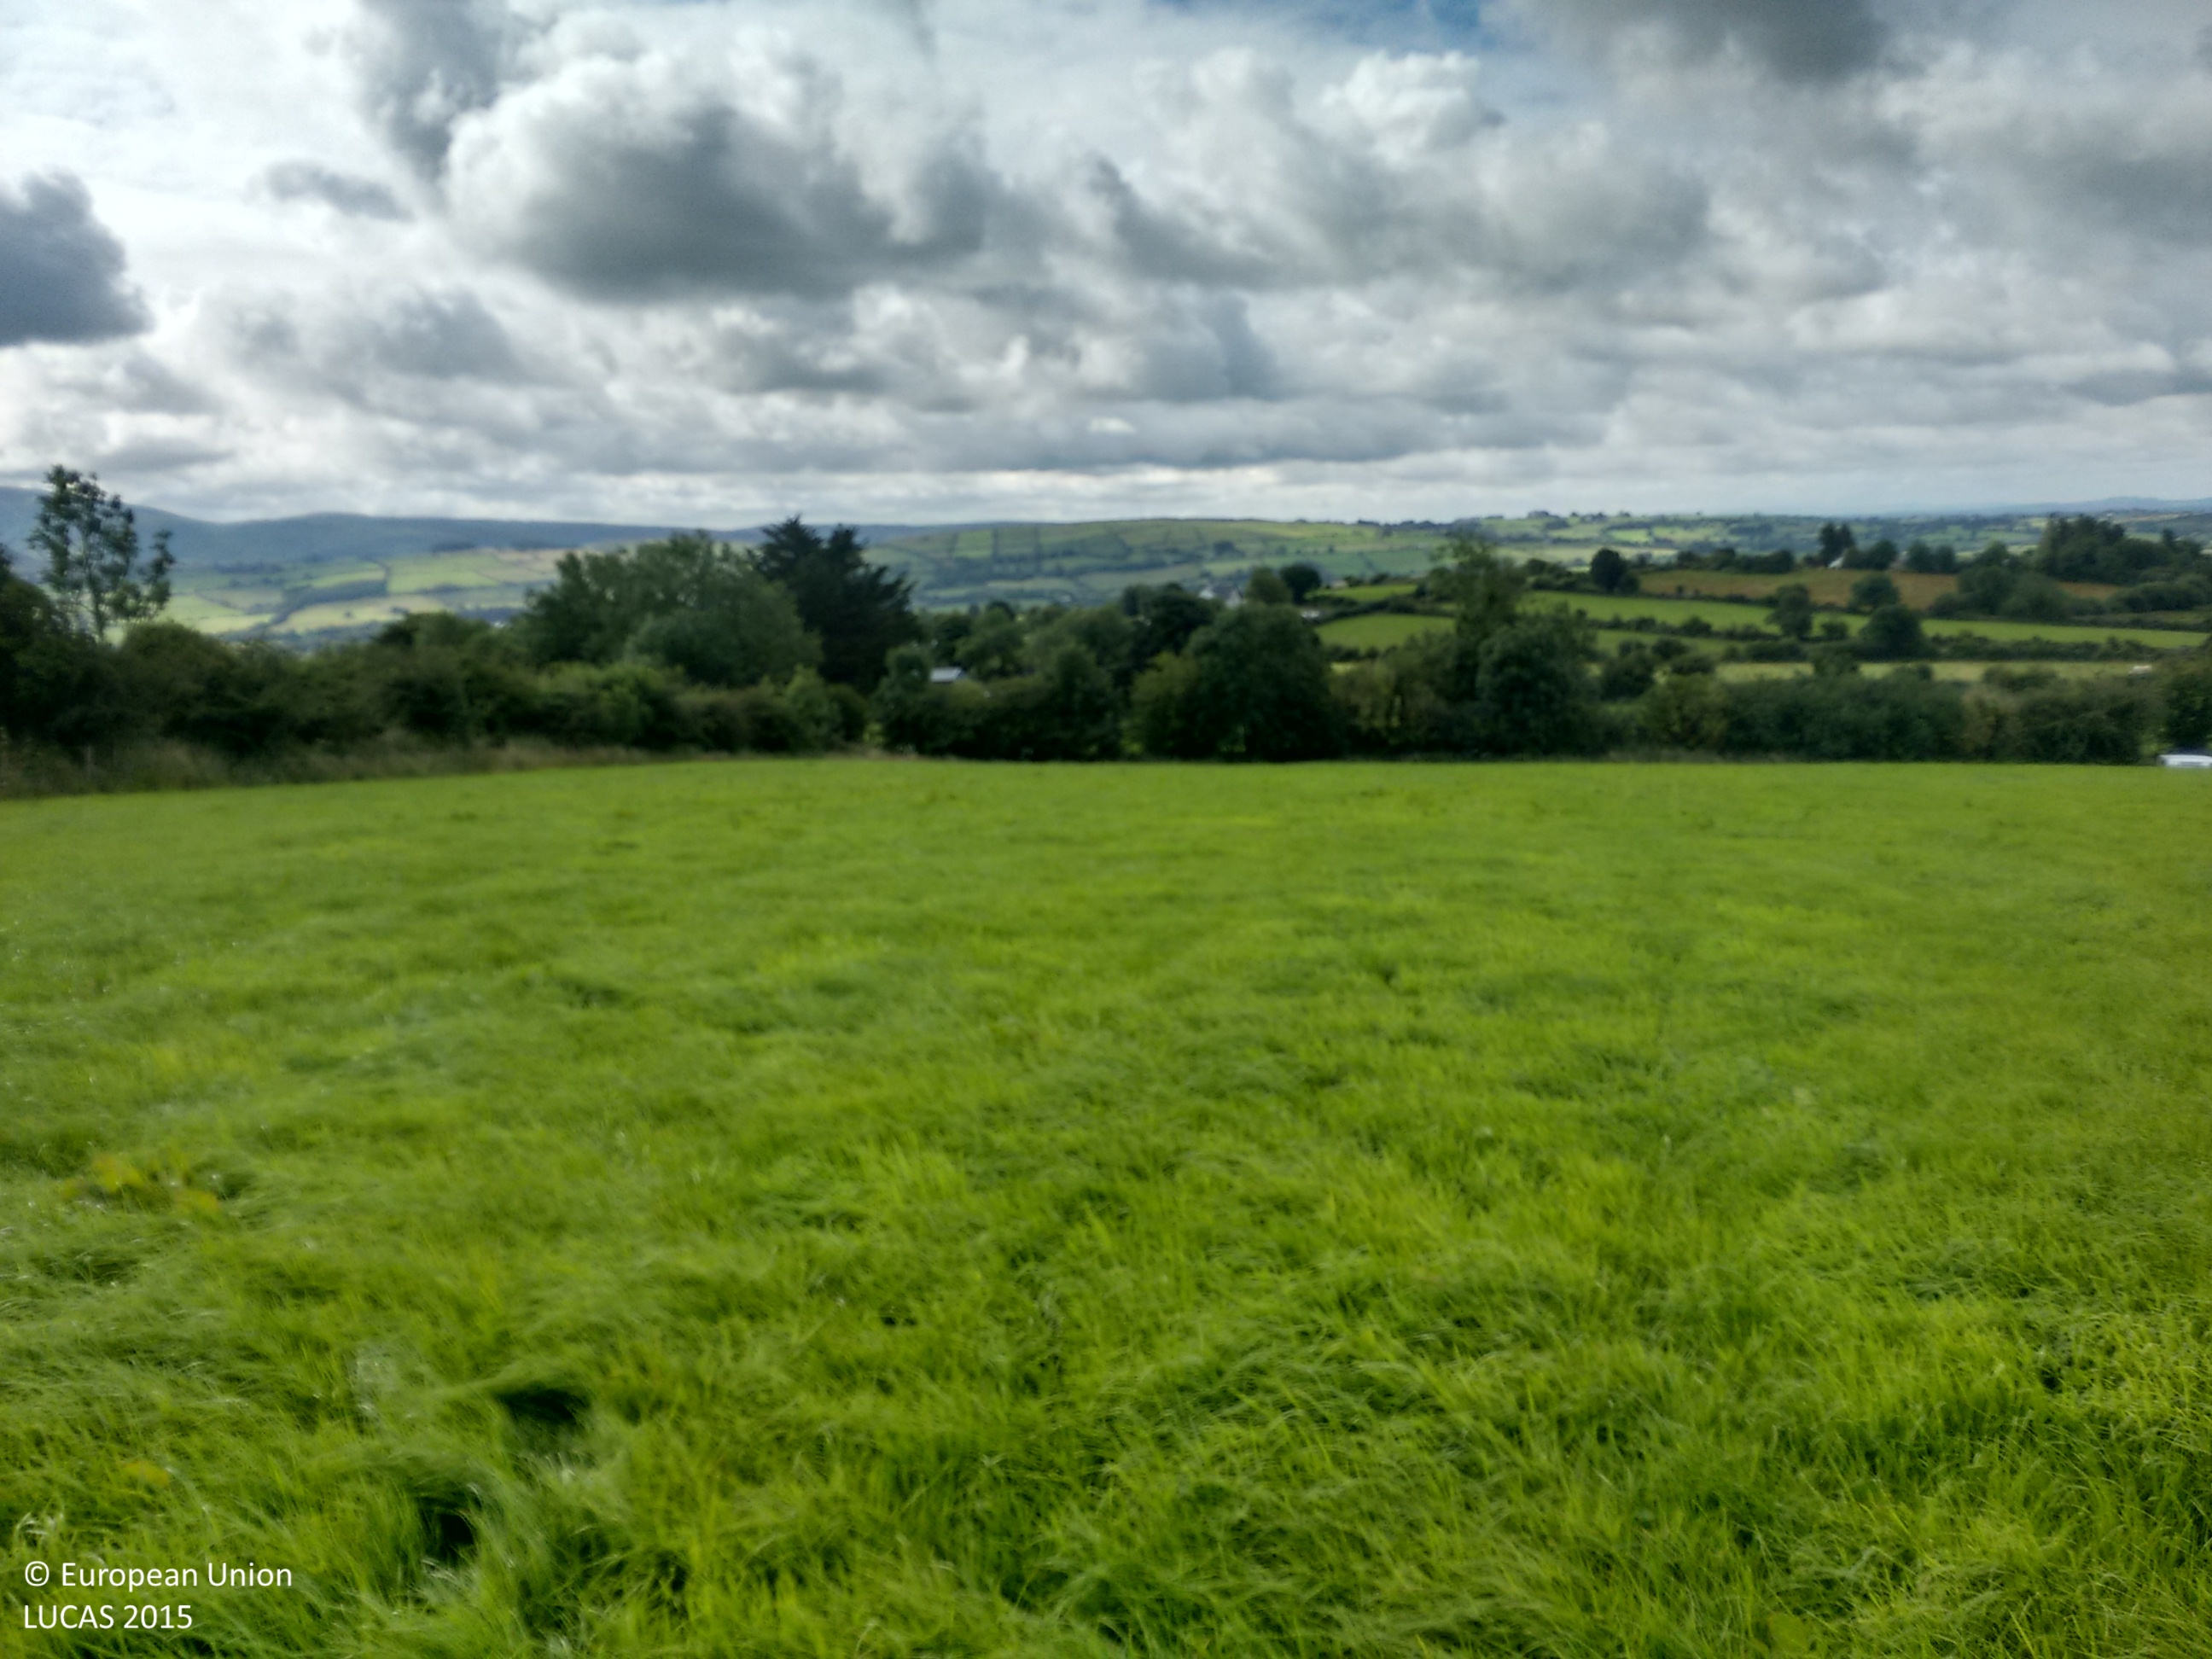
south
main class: Grassland
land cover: Grassland without tree/shrub cover
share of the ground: > 75 %
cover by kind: herbaceous plants 100 %
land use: Agriculture (excluding fallow land and kitchen gardens)
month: July
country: IE
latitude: 52.8106
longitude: -8.3625
